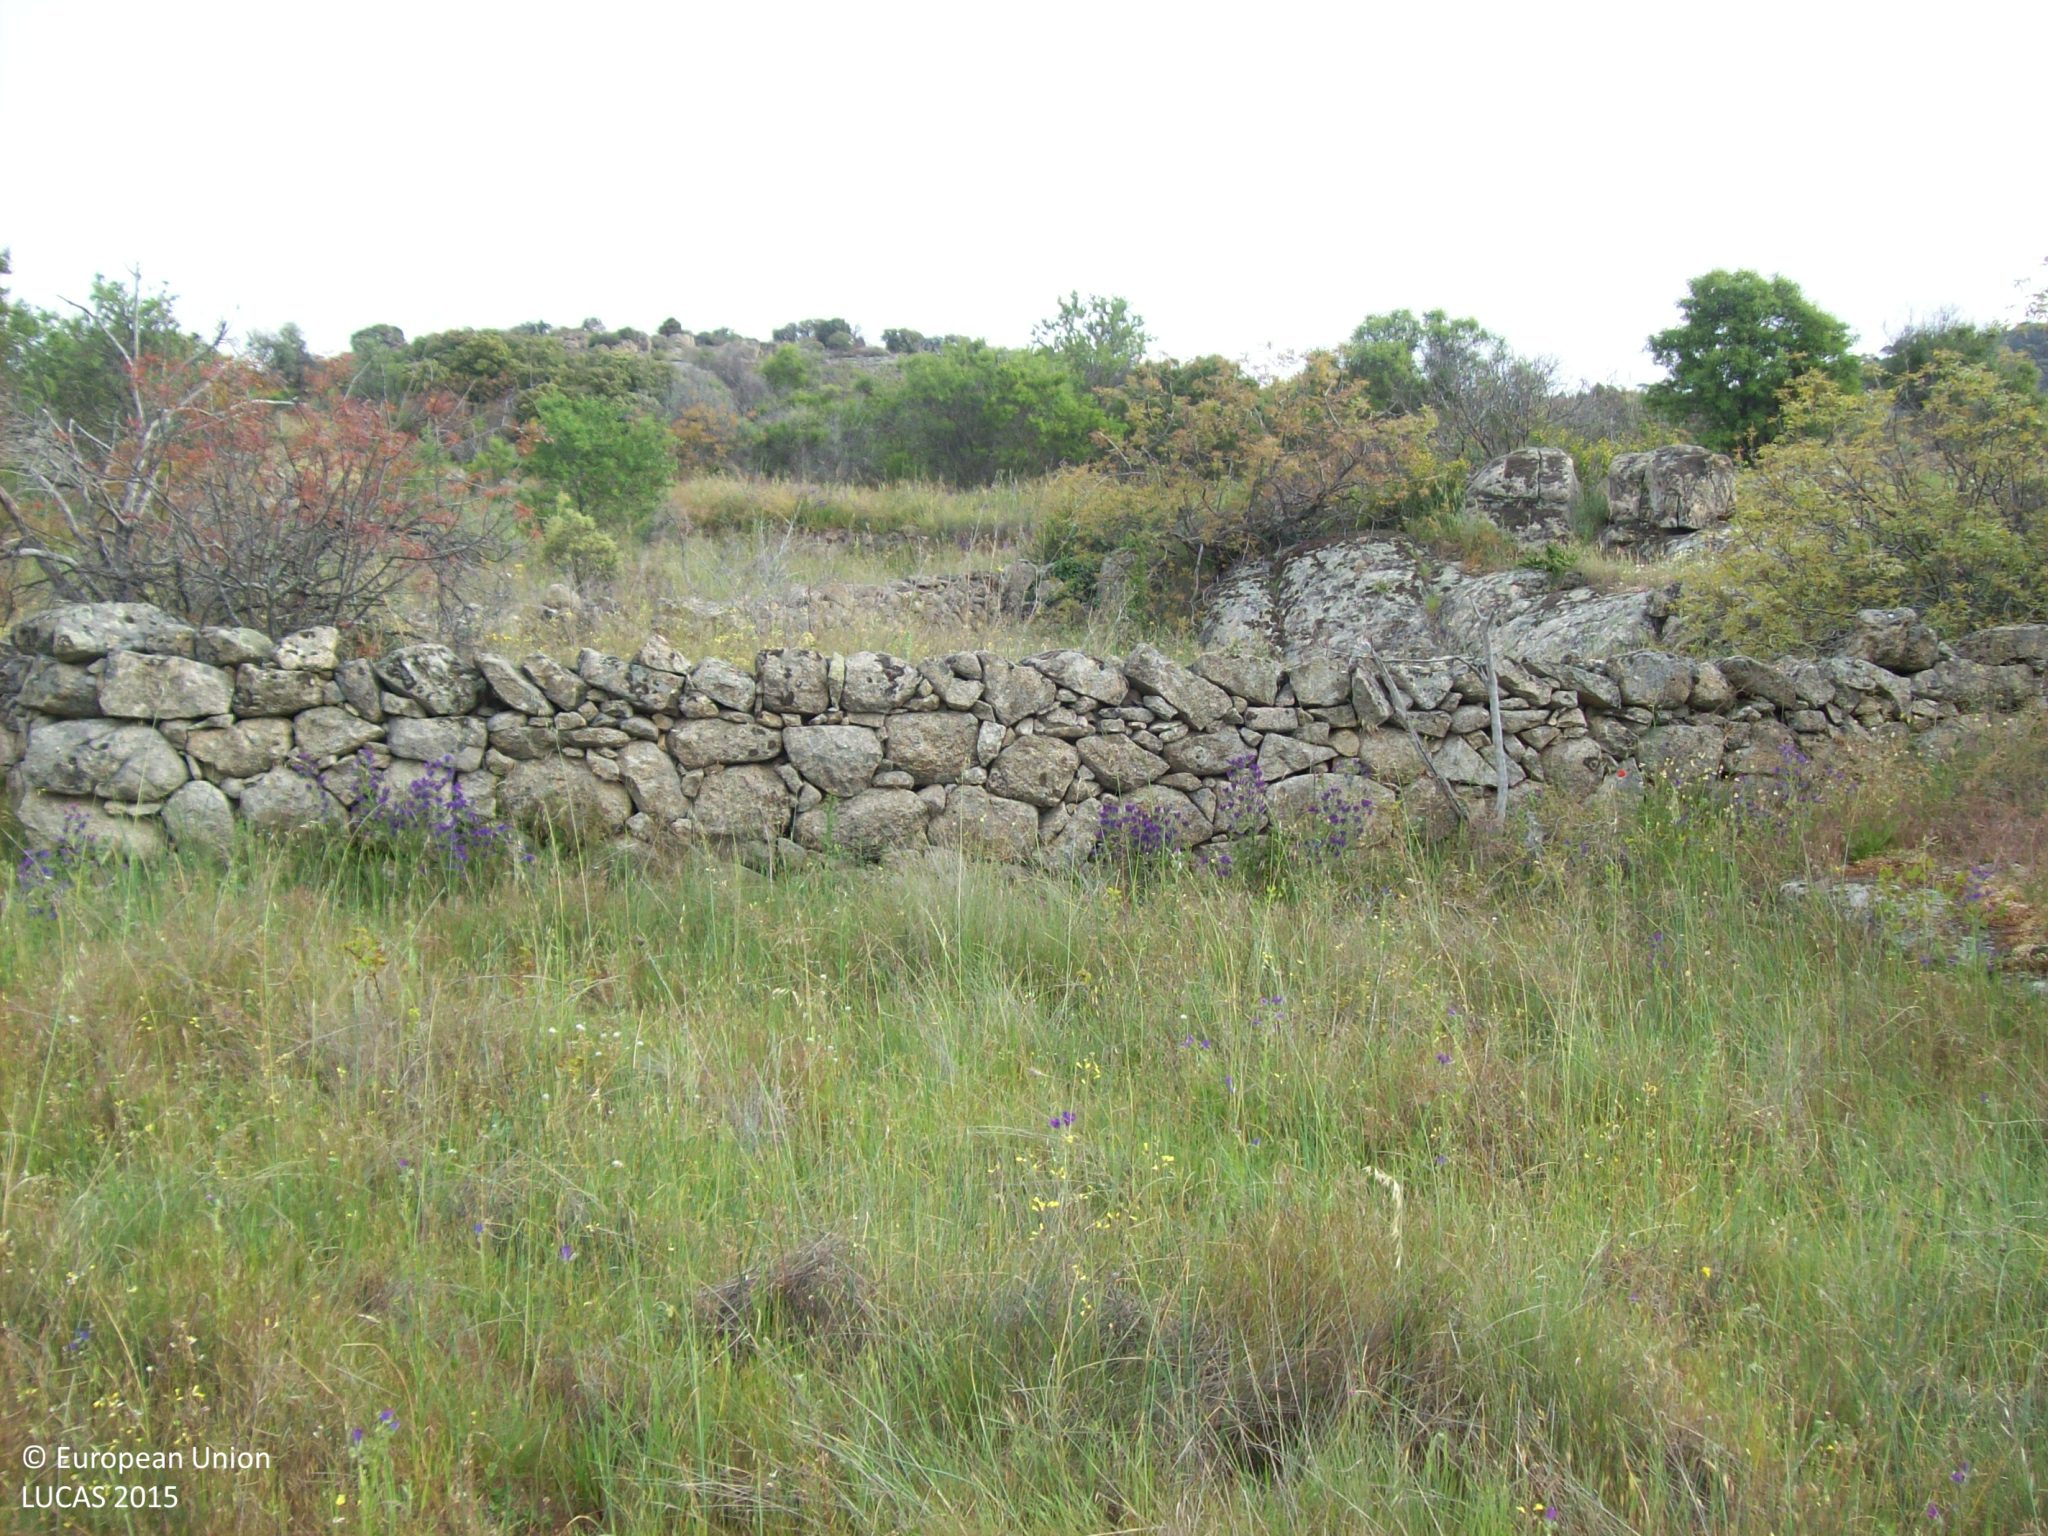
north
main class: Grassland
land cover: Grassland with sparse tree/shrub cover
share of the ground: > 75 %
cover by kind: herbaceous plants 80 %, broadleaved forest trees 5 %, shrubs 5 %, consolidated bare surface 5 %
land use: Abandoned areas
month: April
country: ES
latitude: 40.4431
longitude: -4.4200
